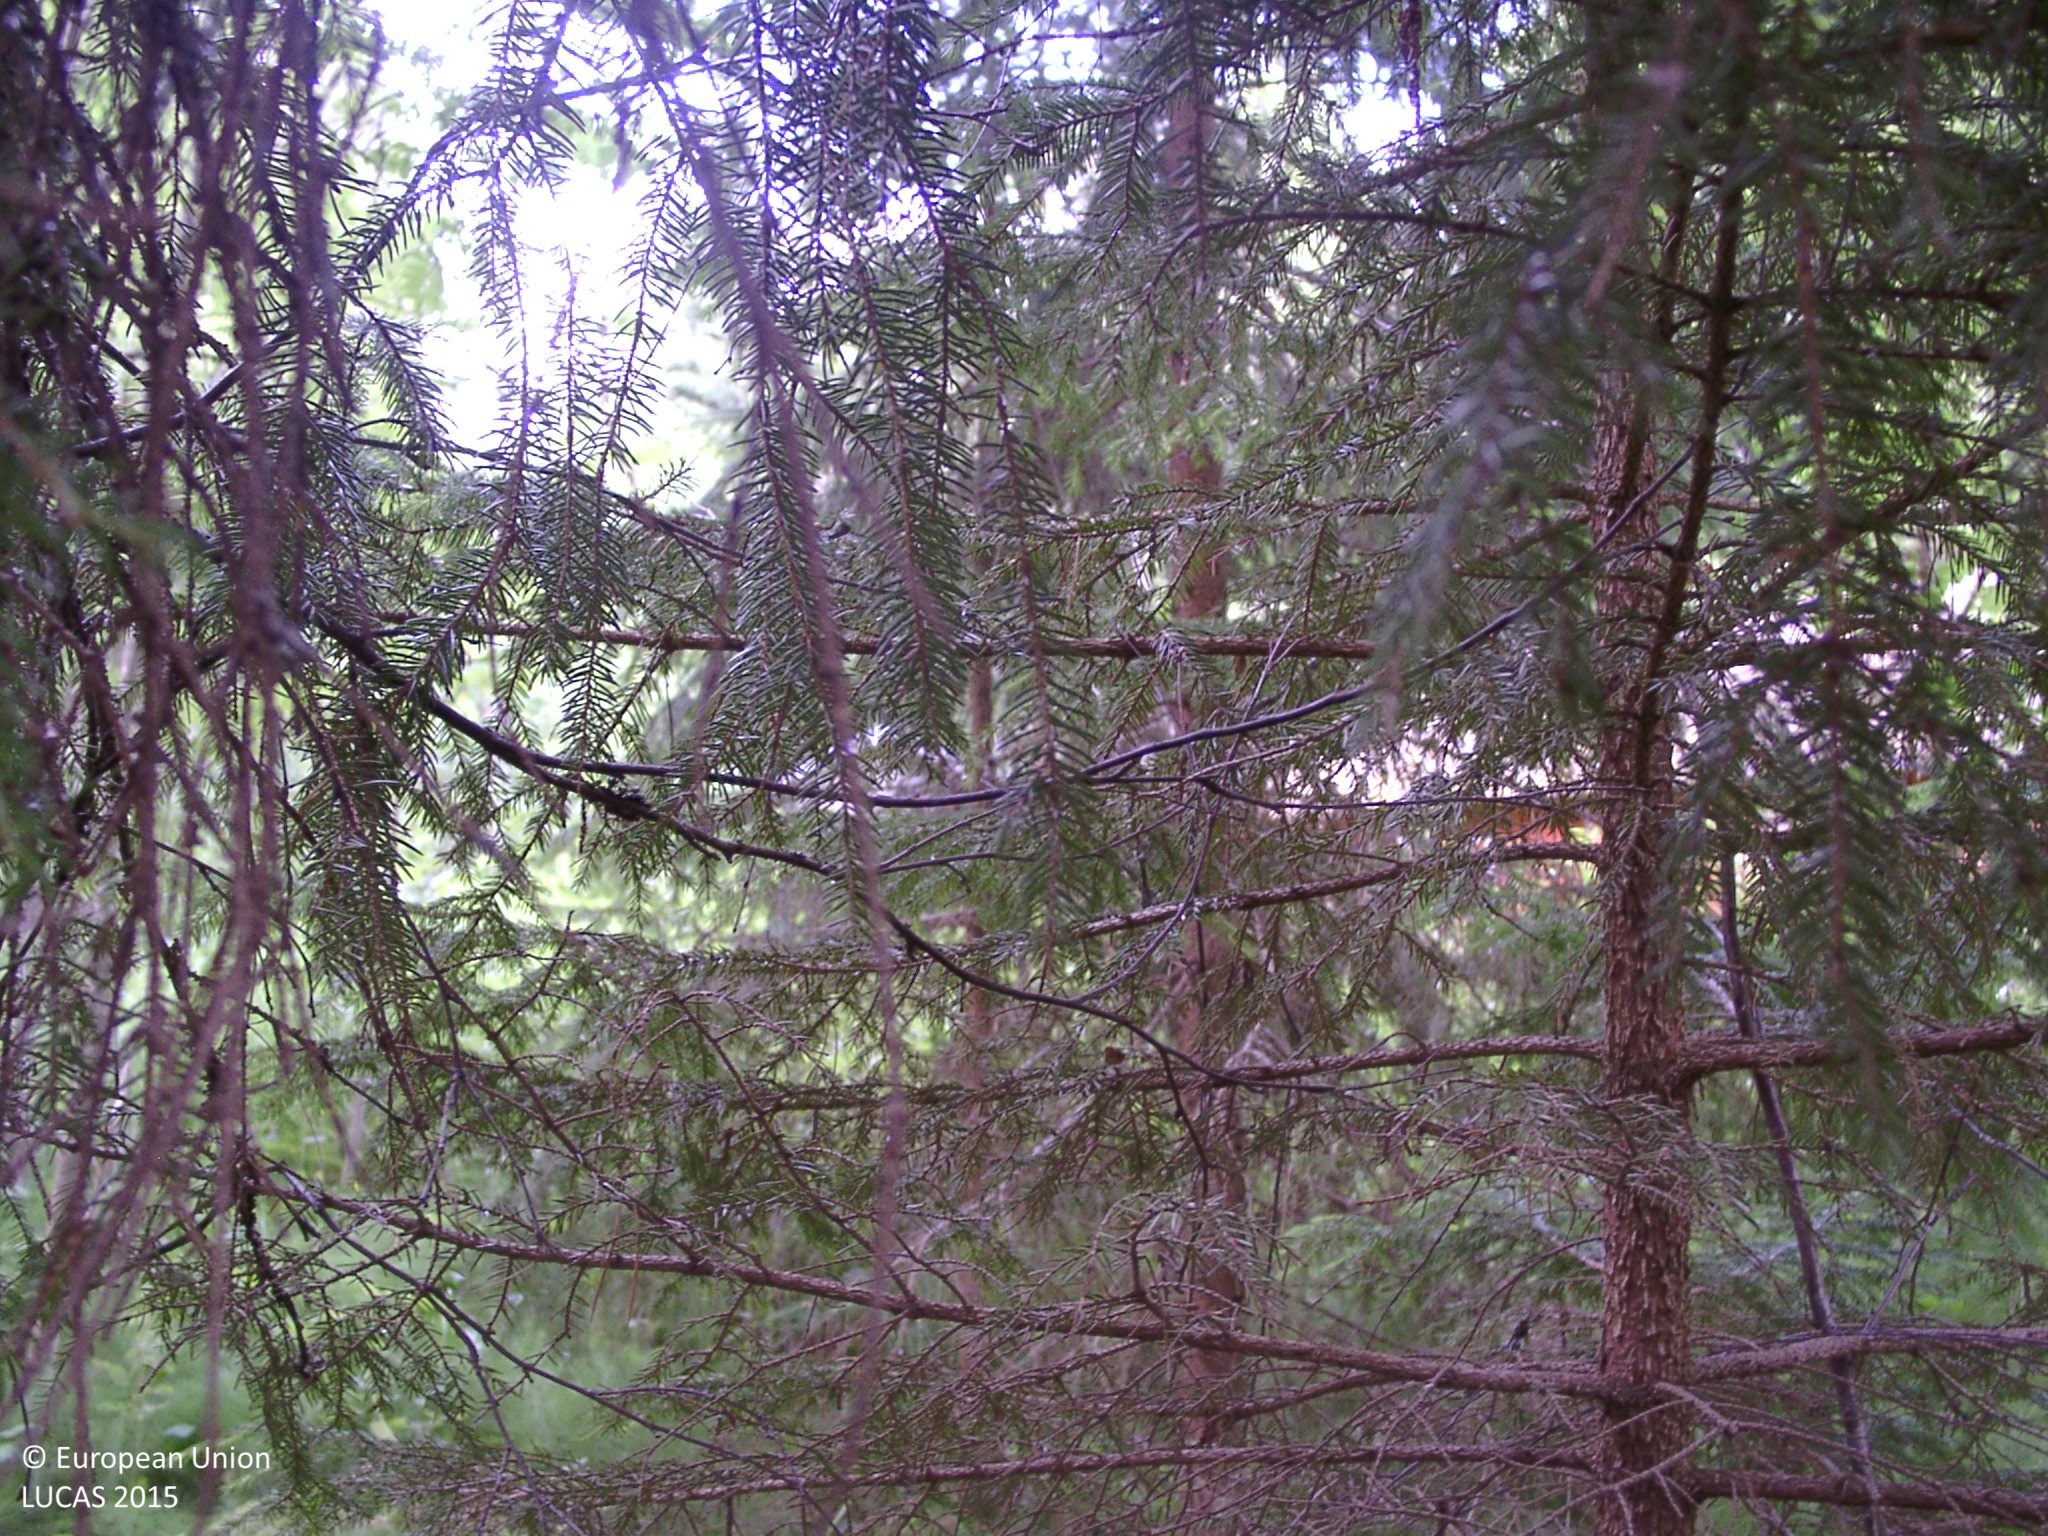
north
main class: Woodland
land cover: Spruce dominated mixed woodland
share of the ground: 50 - 75 %
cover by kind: coniferous forest trees 50 %, herbaceous plants 30 %, broadleaved forest trees 20 %
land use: Semi-natural and natural areas not in use
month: July
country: FI
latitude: 61.6944
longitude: 24.9468
